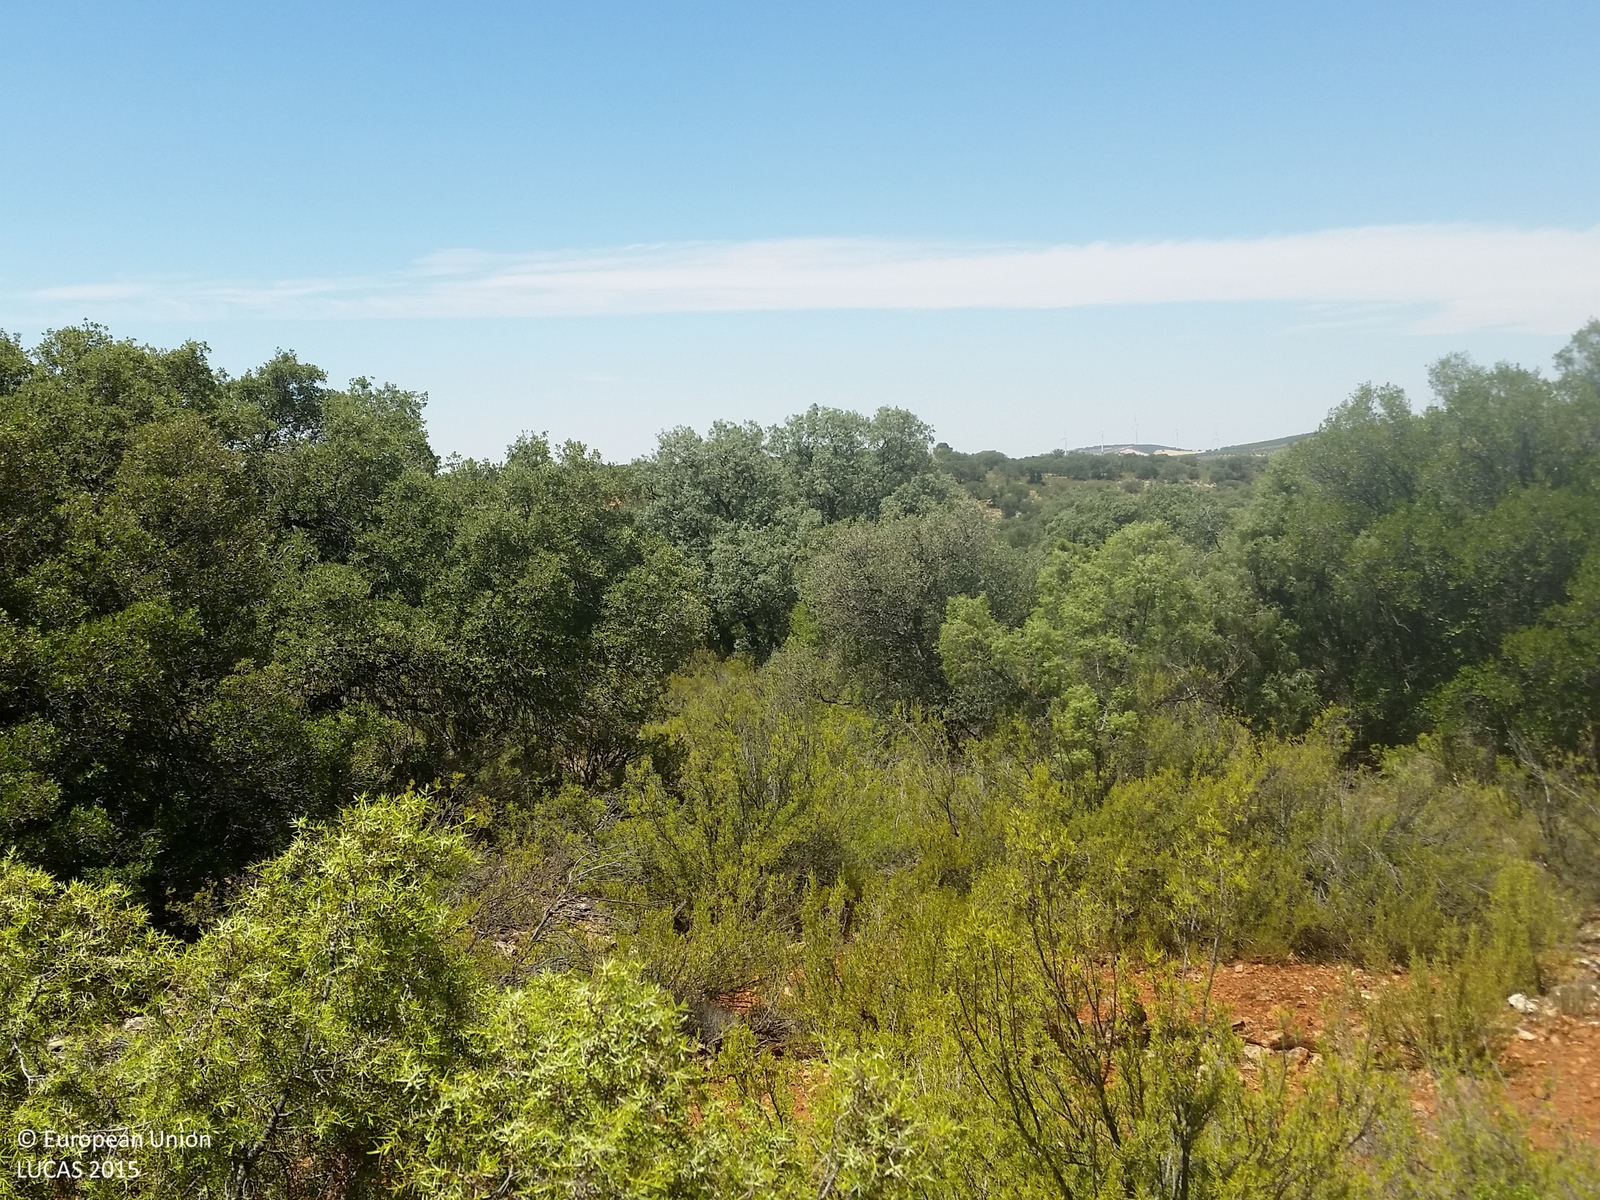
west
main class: Woodland
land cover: Broadleaved woodland
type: broadleaved evergreen forest
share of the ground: > 75 %
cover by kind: broadleaved forest trees 30 %, shrubs 30 %, consolidated bare surface 30 %, herbaceous plants 10 %
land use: Semi-natural and natural areas not in use
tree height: < 5 m
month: July
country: ES
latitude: 39.0234
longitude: -2.6551
